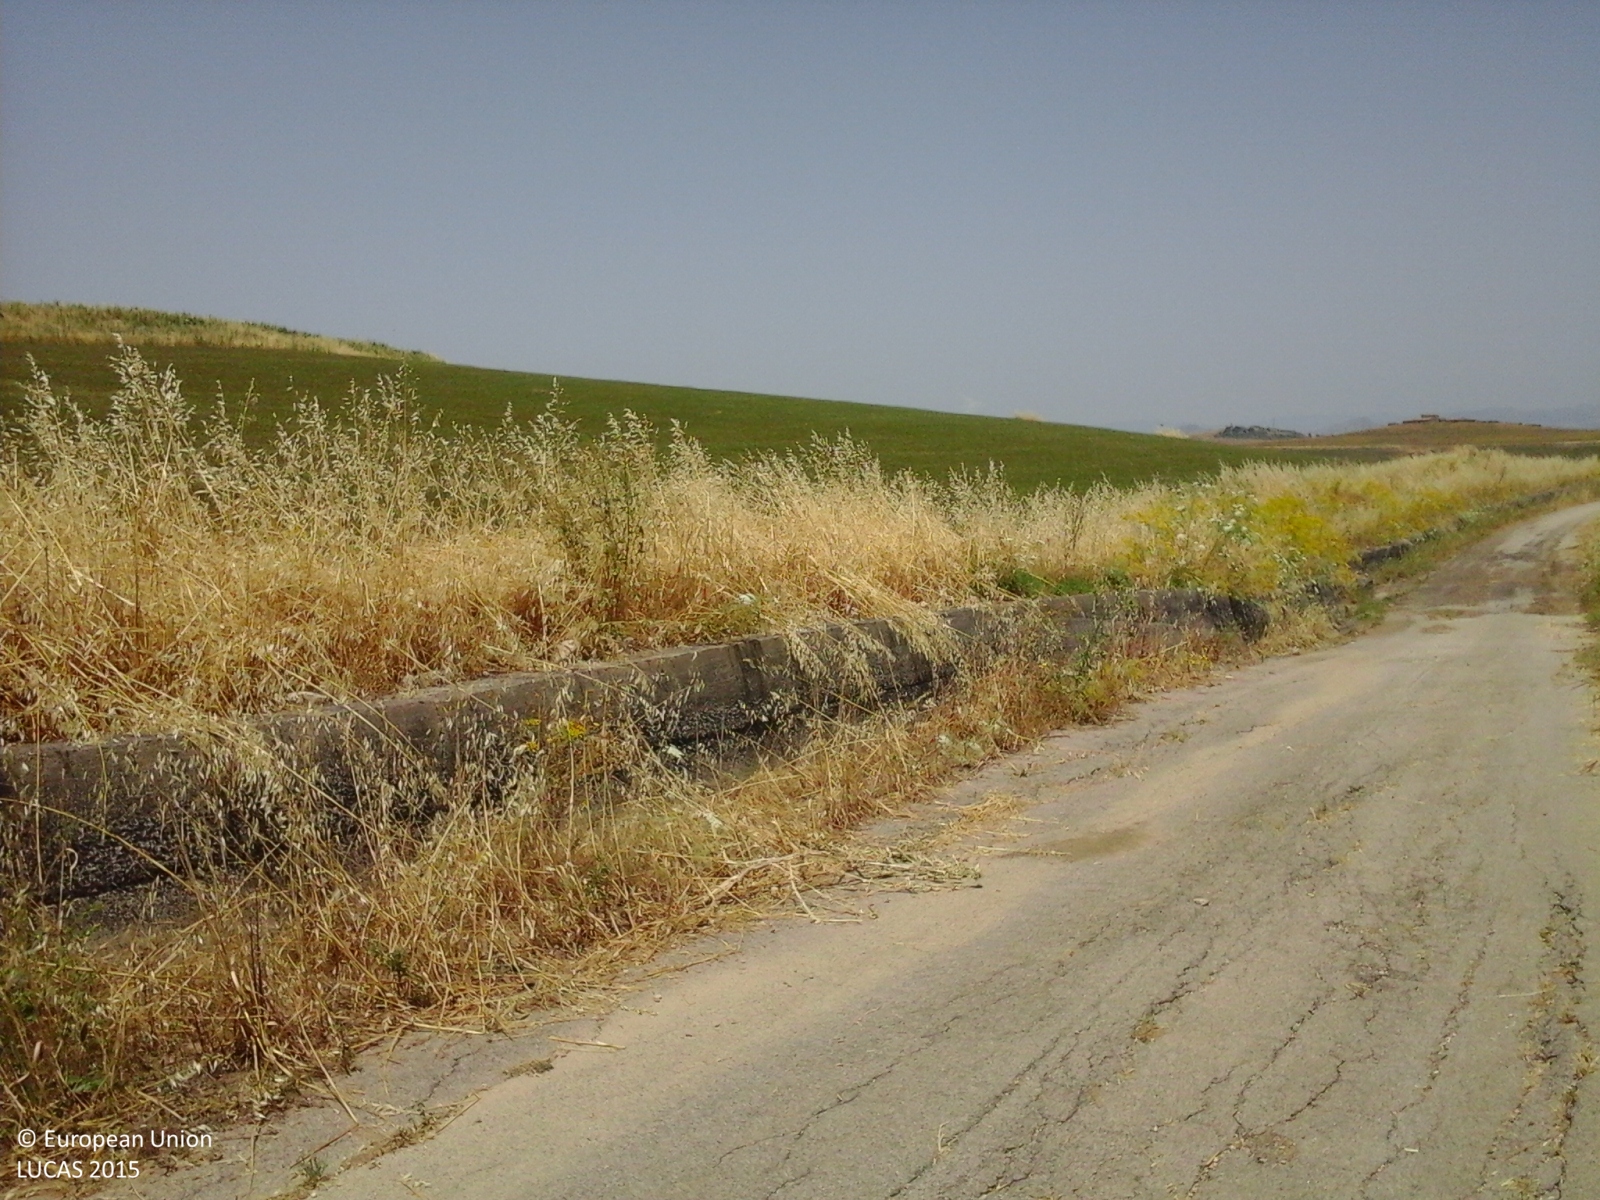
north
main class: Cropland
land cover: Clovers
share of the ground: > 75 %
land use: Agriculture (excluding fallow land and kitchen gardens)
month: June
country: IT
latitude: 37.4976
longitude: 14.4577
